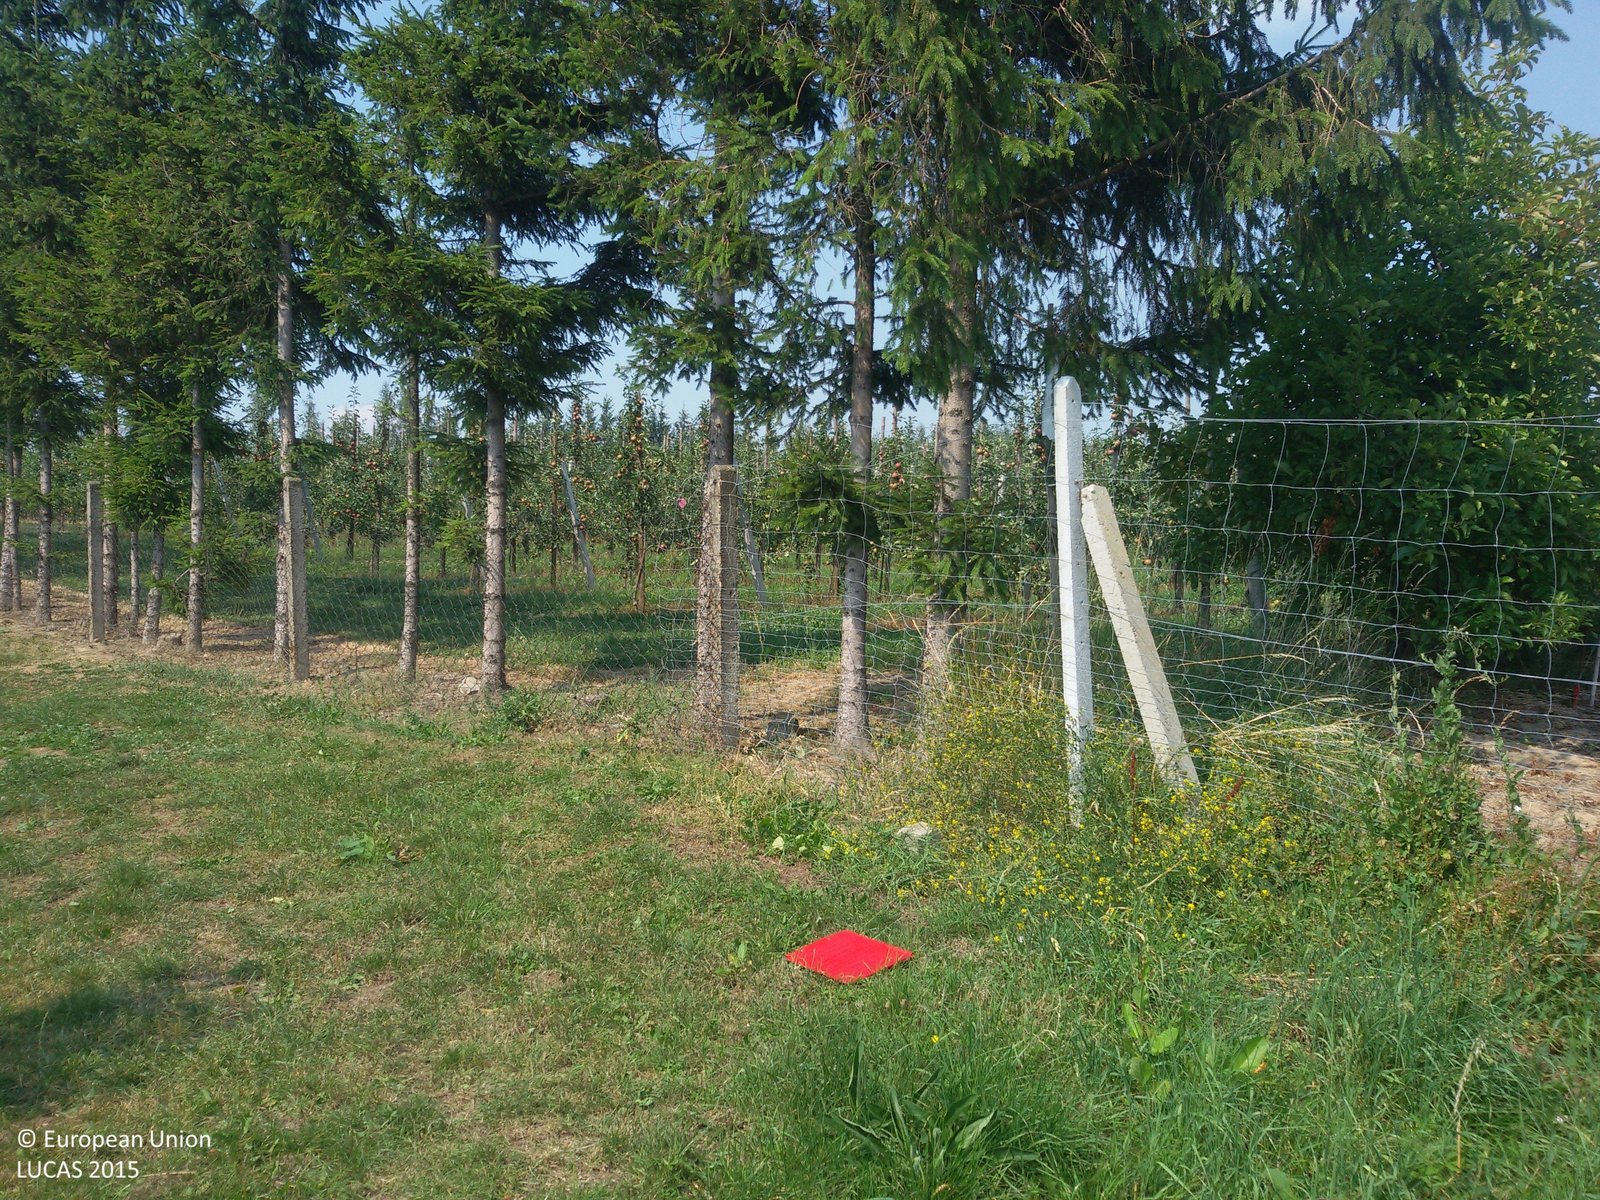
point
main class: Cropland
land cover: Apple fruit
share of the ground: 25 - 50 %
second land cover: Grassland without tree/shrub cover
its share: > 75 %
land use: Agriculture (excluding fallow land and kitchen gardens)
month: August
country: PL
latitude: 49.7990
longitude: 20.1898
